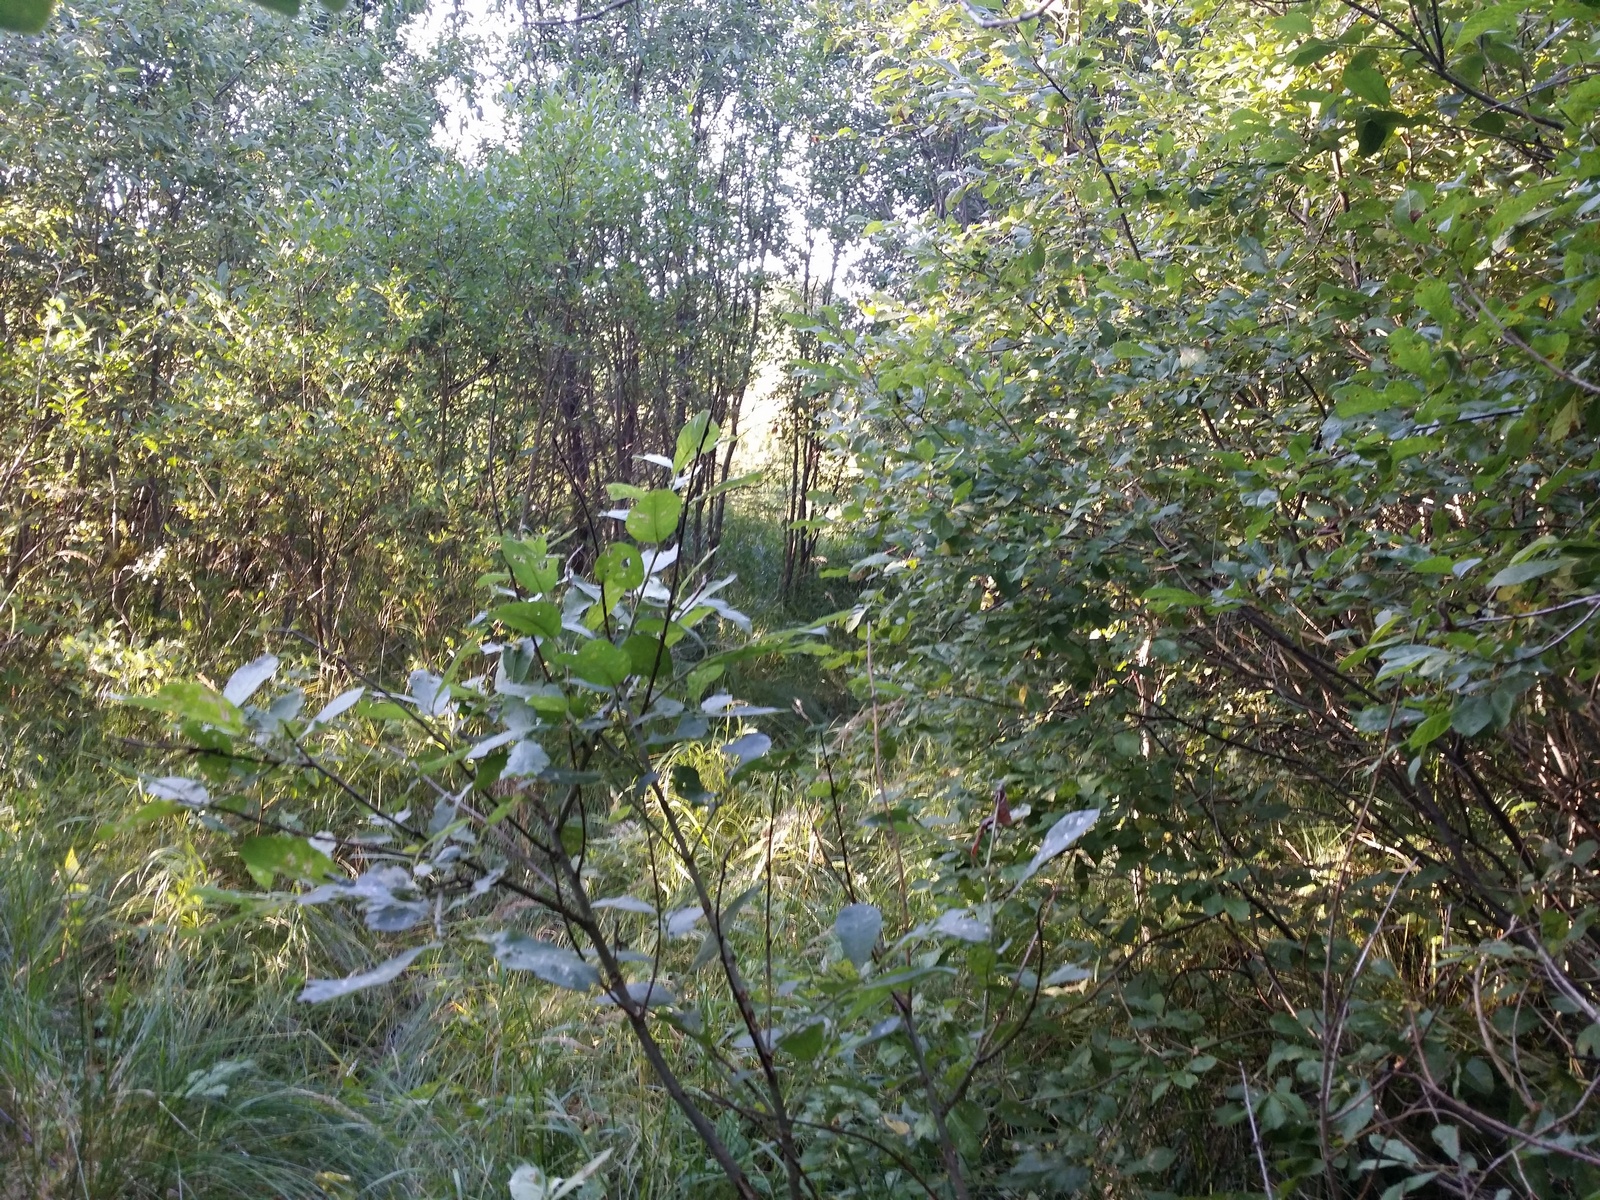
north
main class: Woodland
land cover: Broadleaved woodland
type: non-riverine alder, birch or aspen forest
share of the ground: > 75 %
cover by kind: broadleaved forest trees 85 %, shrubs 10 %, herbaceous plants 5 %
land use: Forestry
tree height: > 5 m
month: August
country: LV
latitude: 57.5934
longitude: 26.9354
